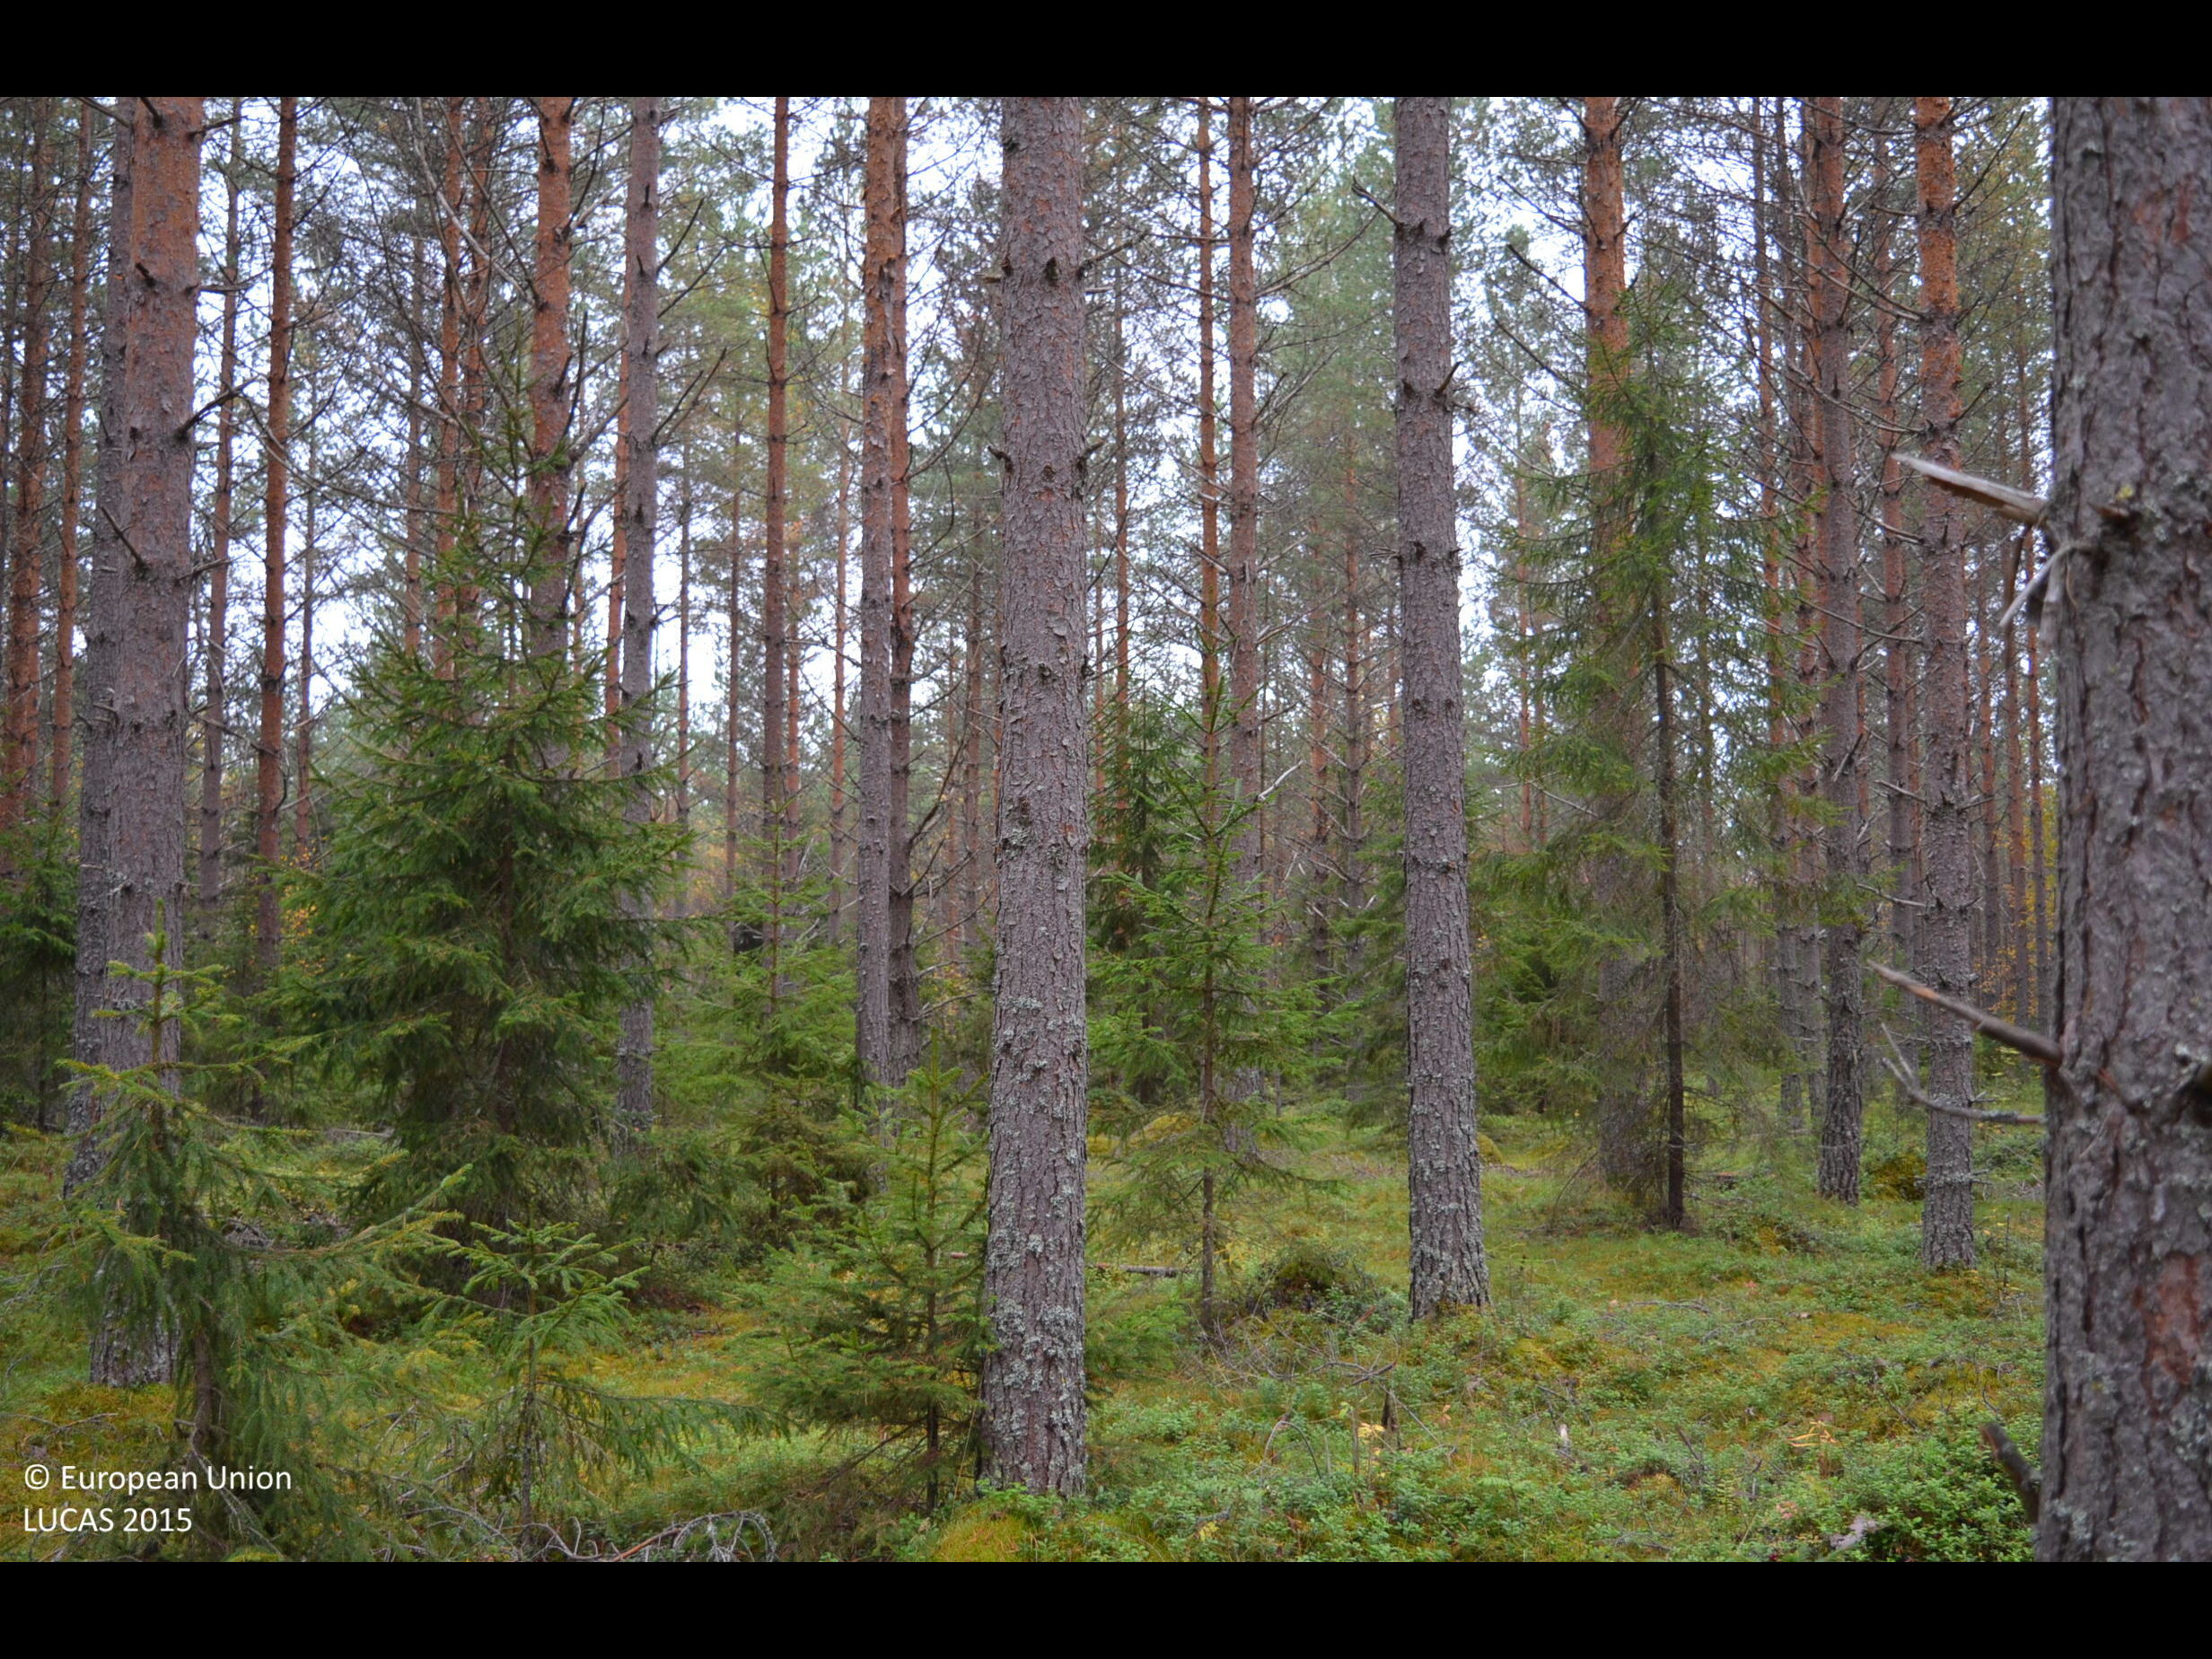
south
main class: Woodland
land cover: Other coniferous woodland
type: boreal forest
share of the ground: 50 - 75 %
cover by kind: coniferous forest trees 70 %, shrubs 20 %, lichens and mosses 10 %
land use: Forestry
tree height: > 5 m
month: September
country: FI
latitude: 62.4978
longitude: 23.6814
